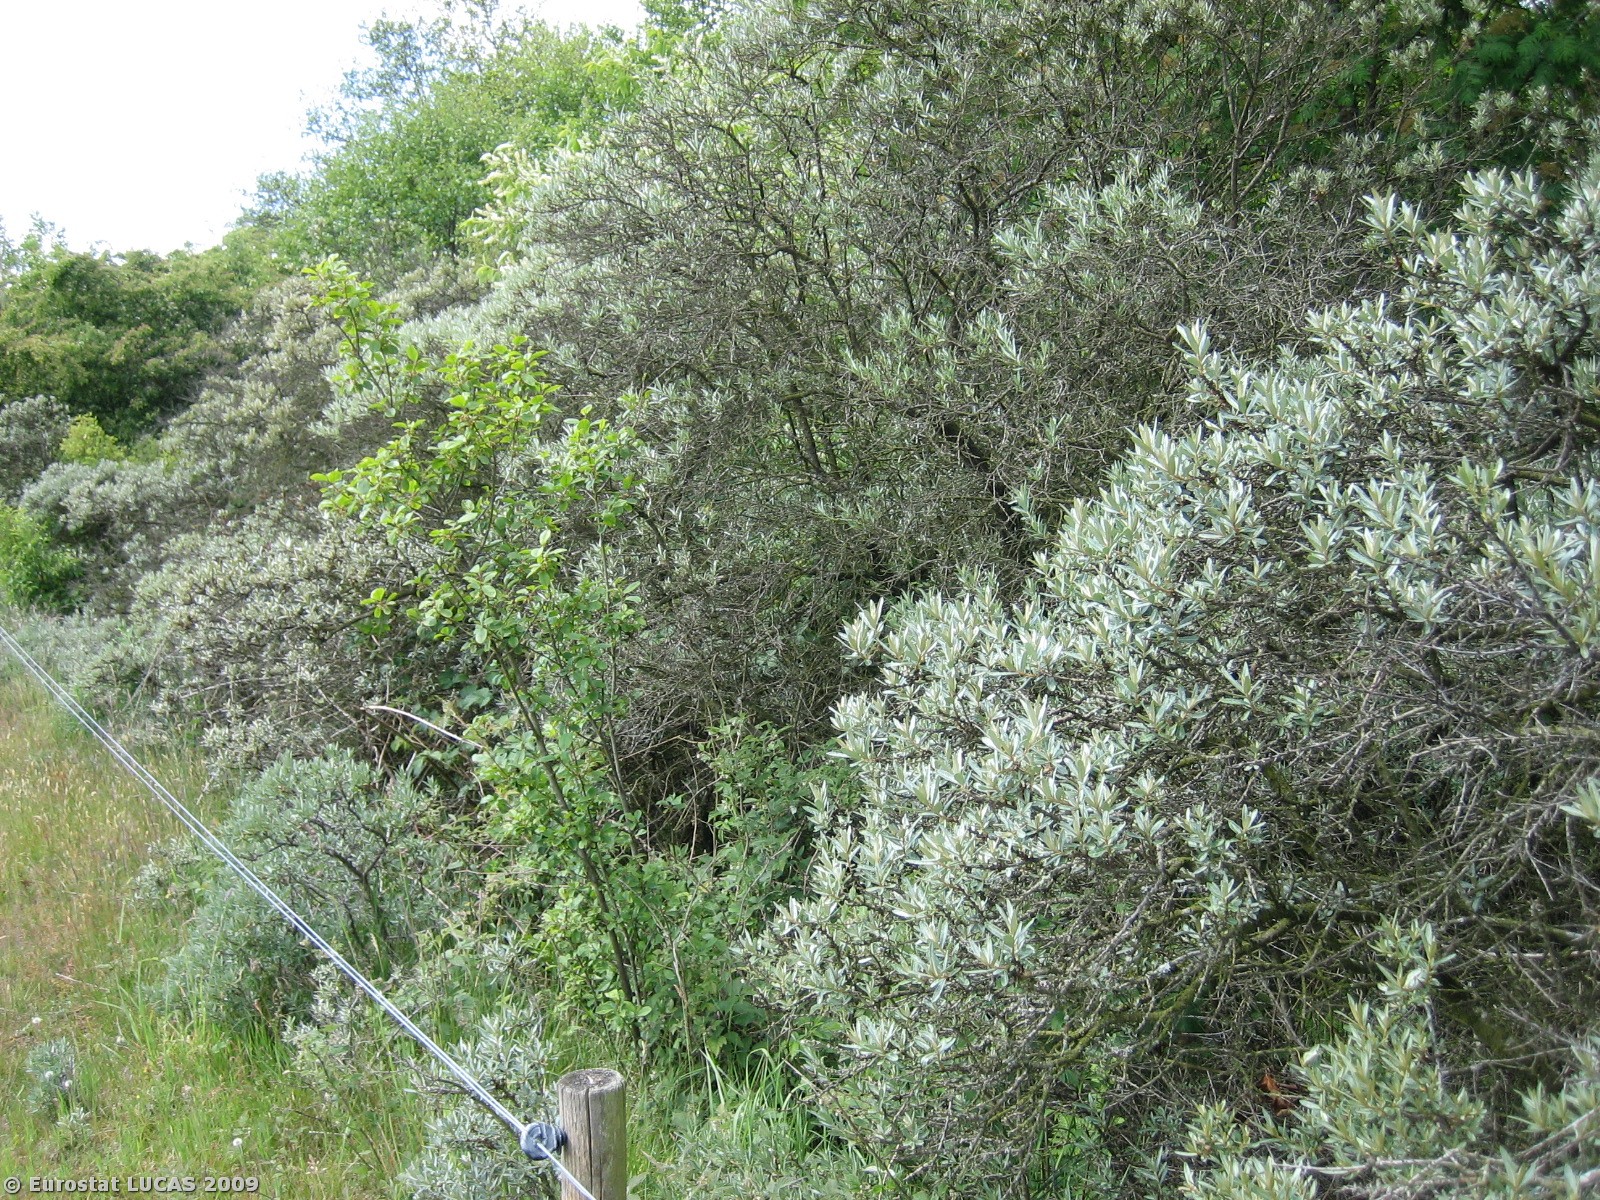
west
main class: Woodland
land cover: Broadleaved woodland
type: mesophytic deciduous forest
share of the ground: > 75 %
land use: Forestry
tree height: > 5 m
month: June
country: DK
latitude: 56.0616
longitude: 9.7273
